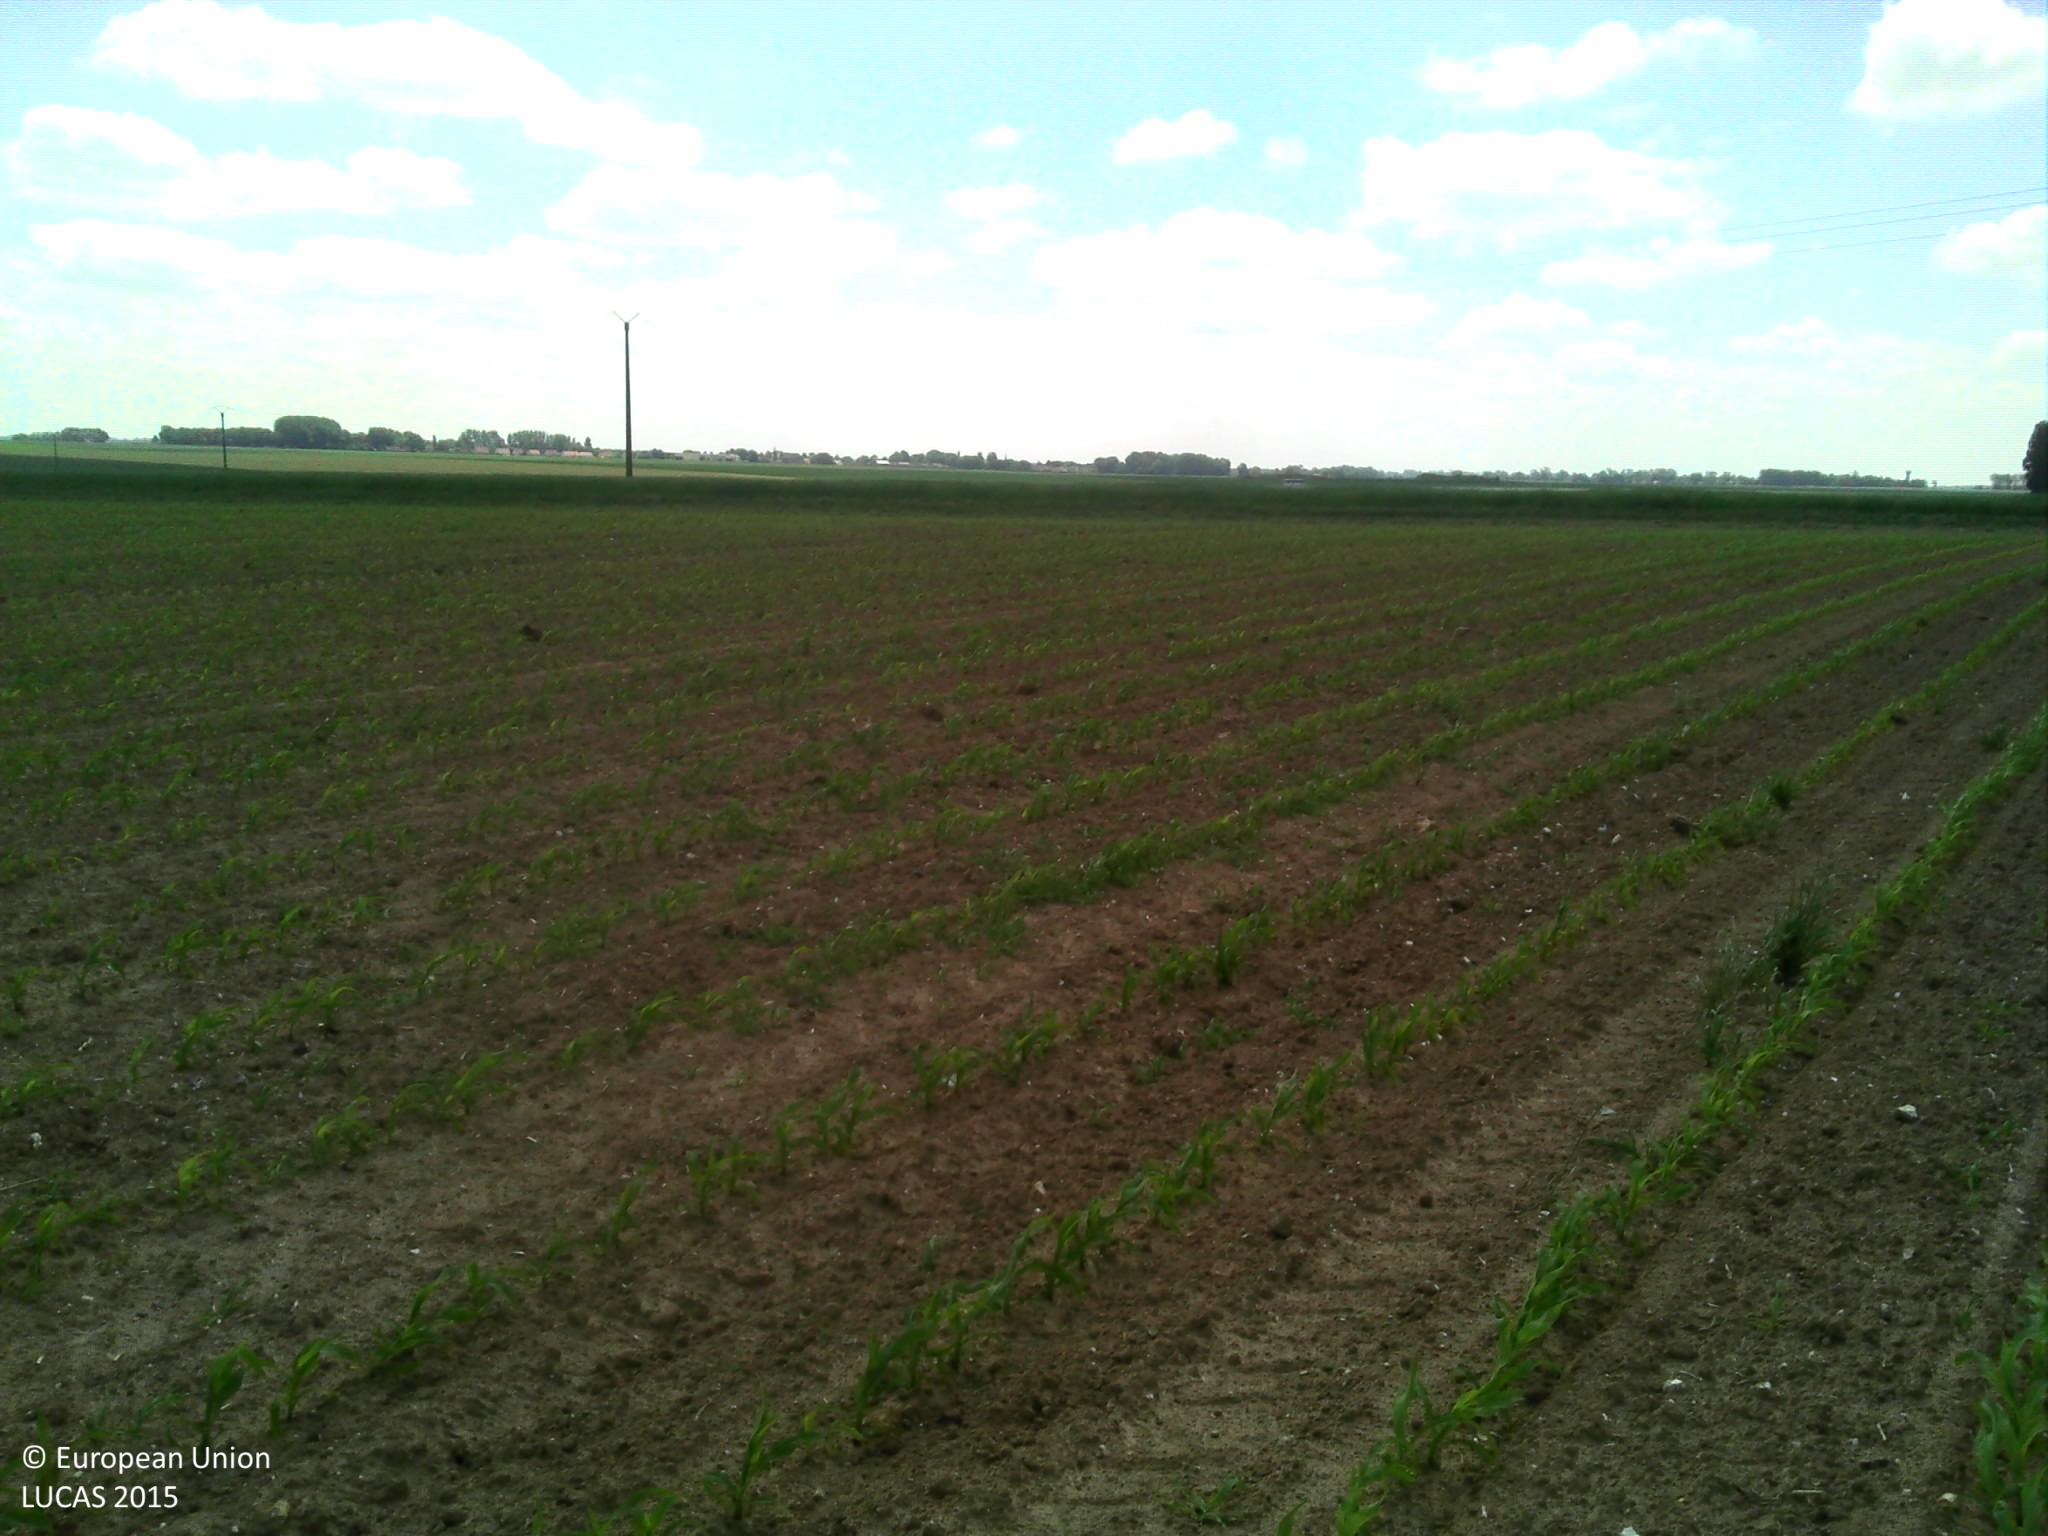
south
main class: Cropland
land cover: Maize
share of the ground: > 75 %
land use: Agriculture (excluding fallow land and kitchen gardens)
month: June
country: FR
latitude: 50.1334
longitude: 1.6863
